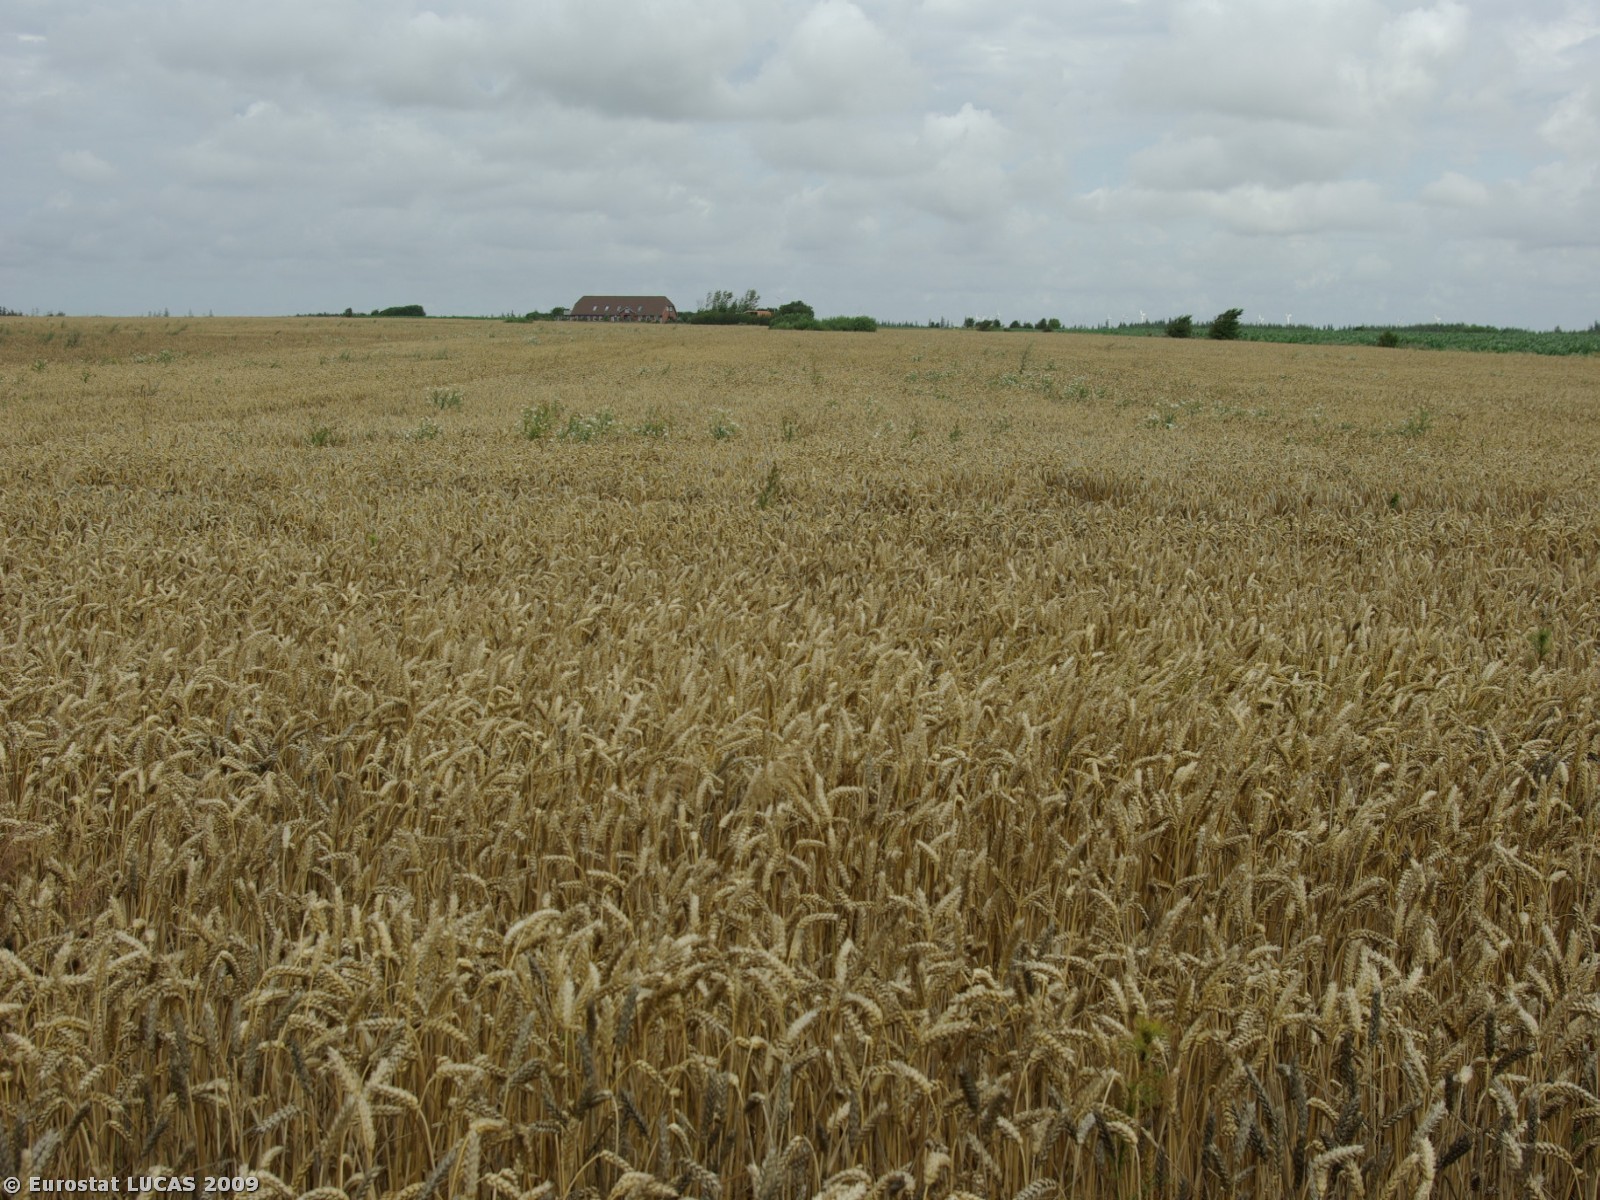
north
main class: Cropland
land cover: Common wheat
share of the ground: > 75 %
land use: Agriculture (excluding fallow land and kitchen gardens)
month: July
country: DK
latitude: 54.9944
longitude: 8.6724
